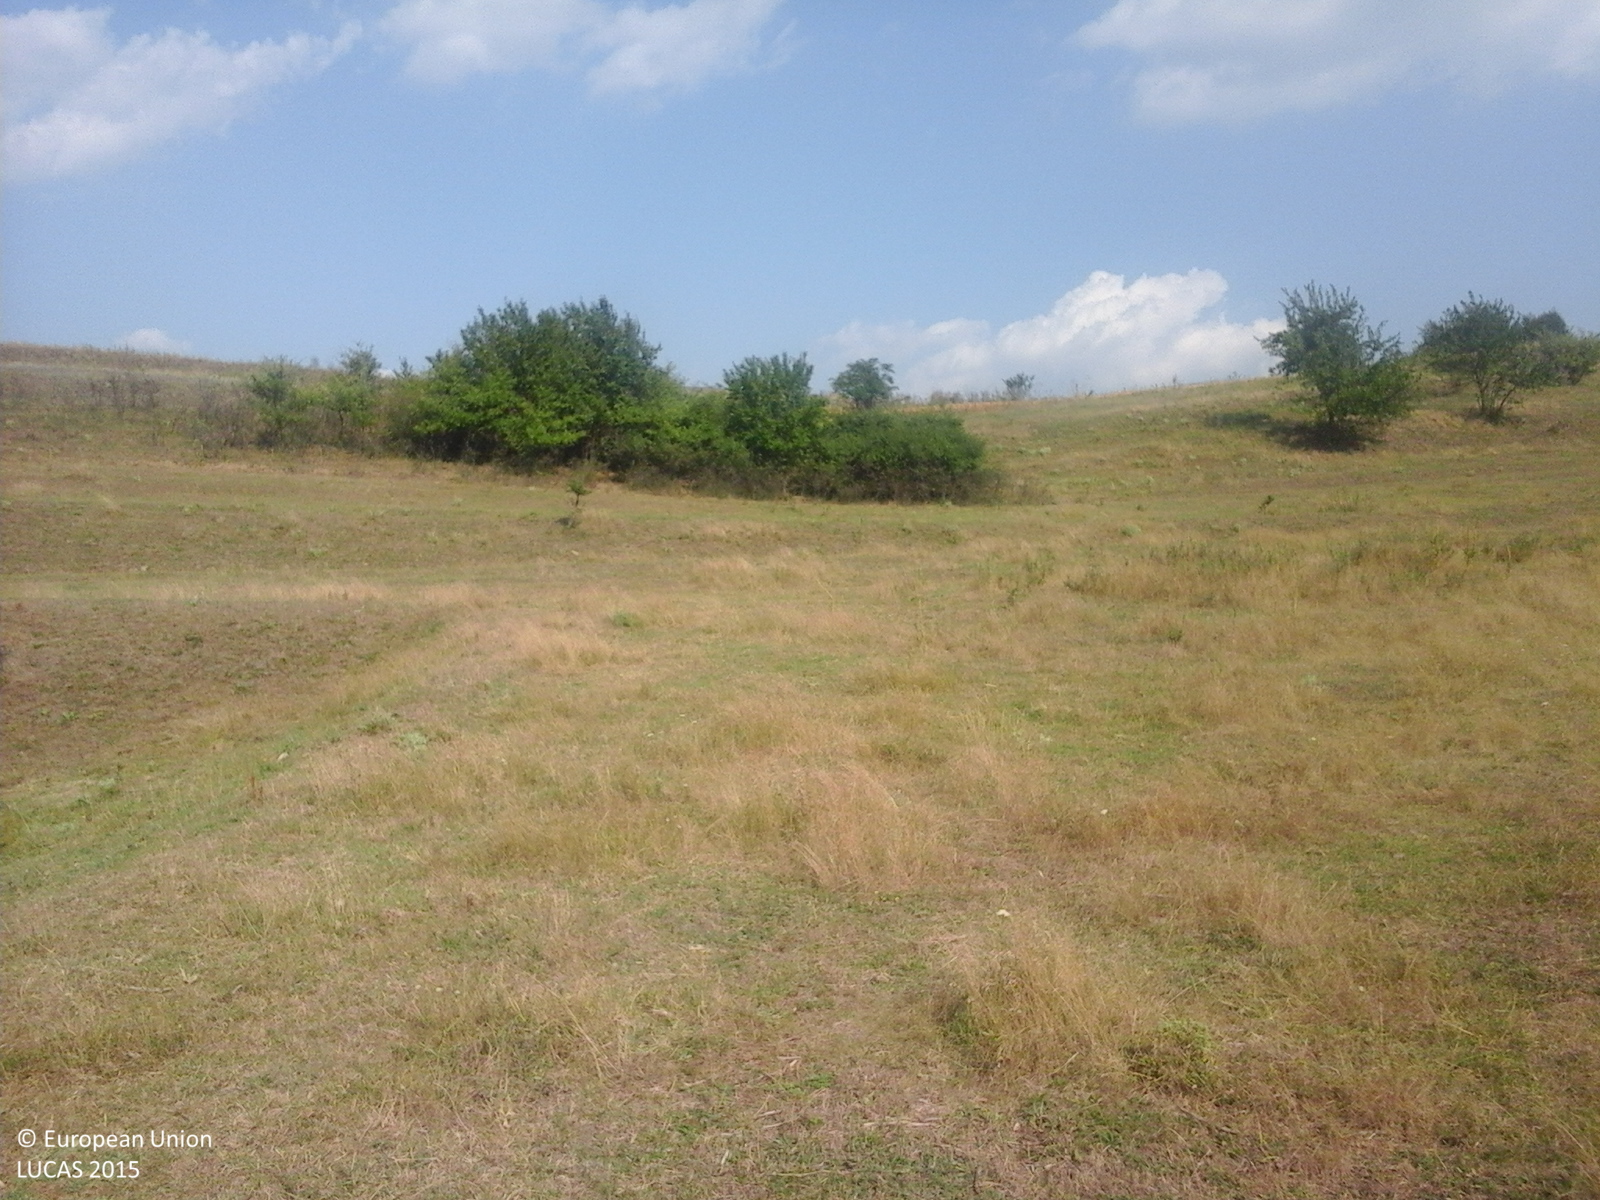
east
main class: Grassland
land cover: Grassland with sparse tree/shrub cover
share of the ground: > 75 %
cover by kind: herbaceous plants 95 %, broadleaved forest trees 5 %
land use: Agriculture (excluding fallow land and kitchen gardens)
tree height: > 5 m
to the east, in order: Grassland with sparse tree/shrub cover; Shrubland with sparse tree cover; Grassland without tree/shrub cover; Common wheat
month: July
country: RO
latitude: 46.1002
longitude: 27.7733
